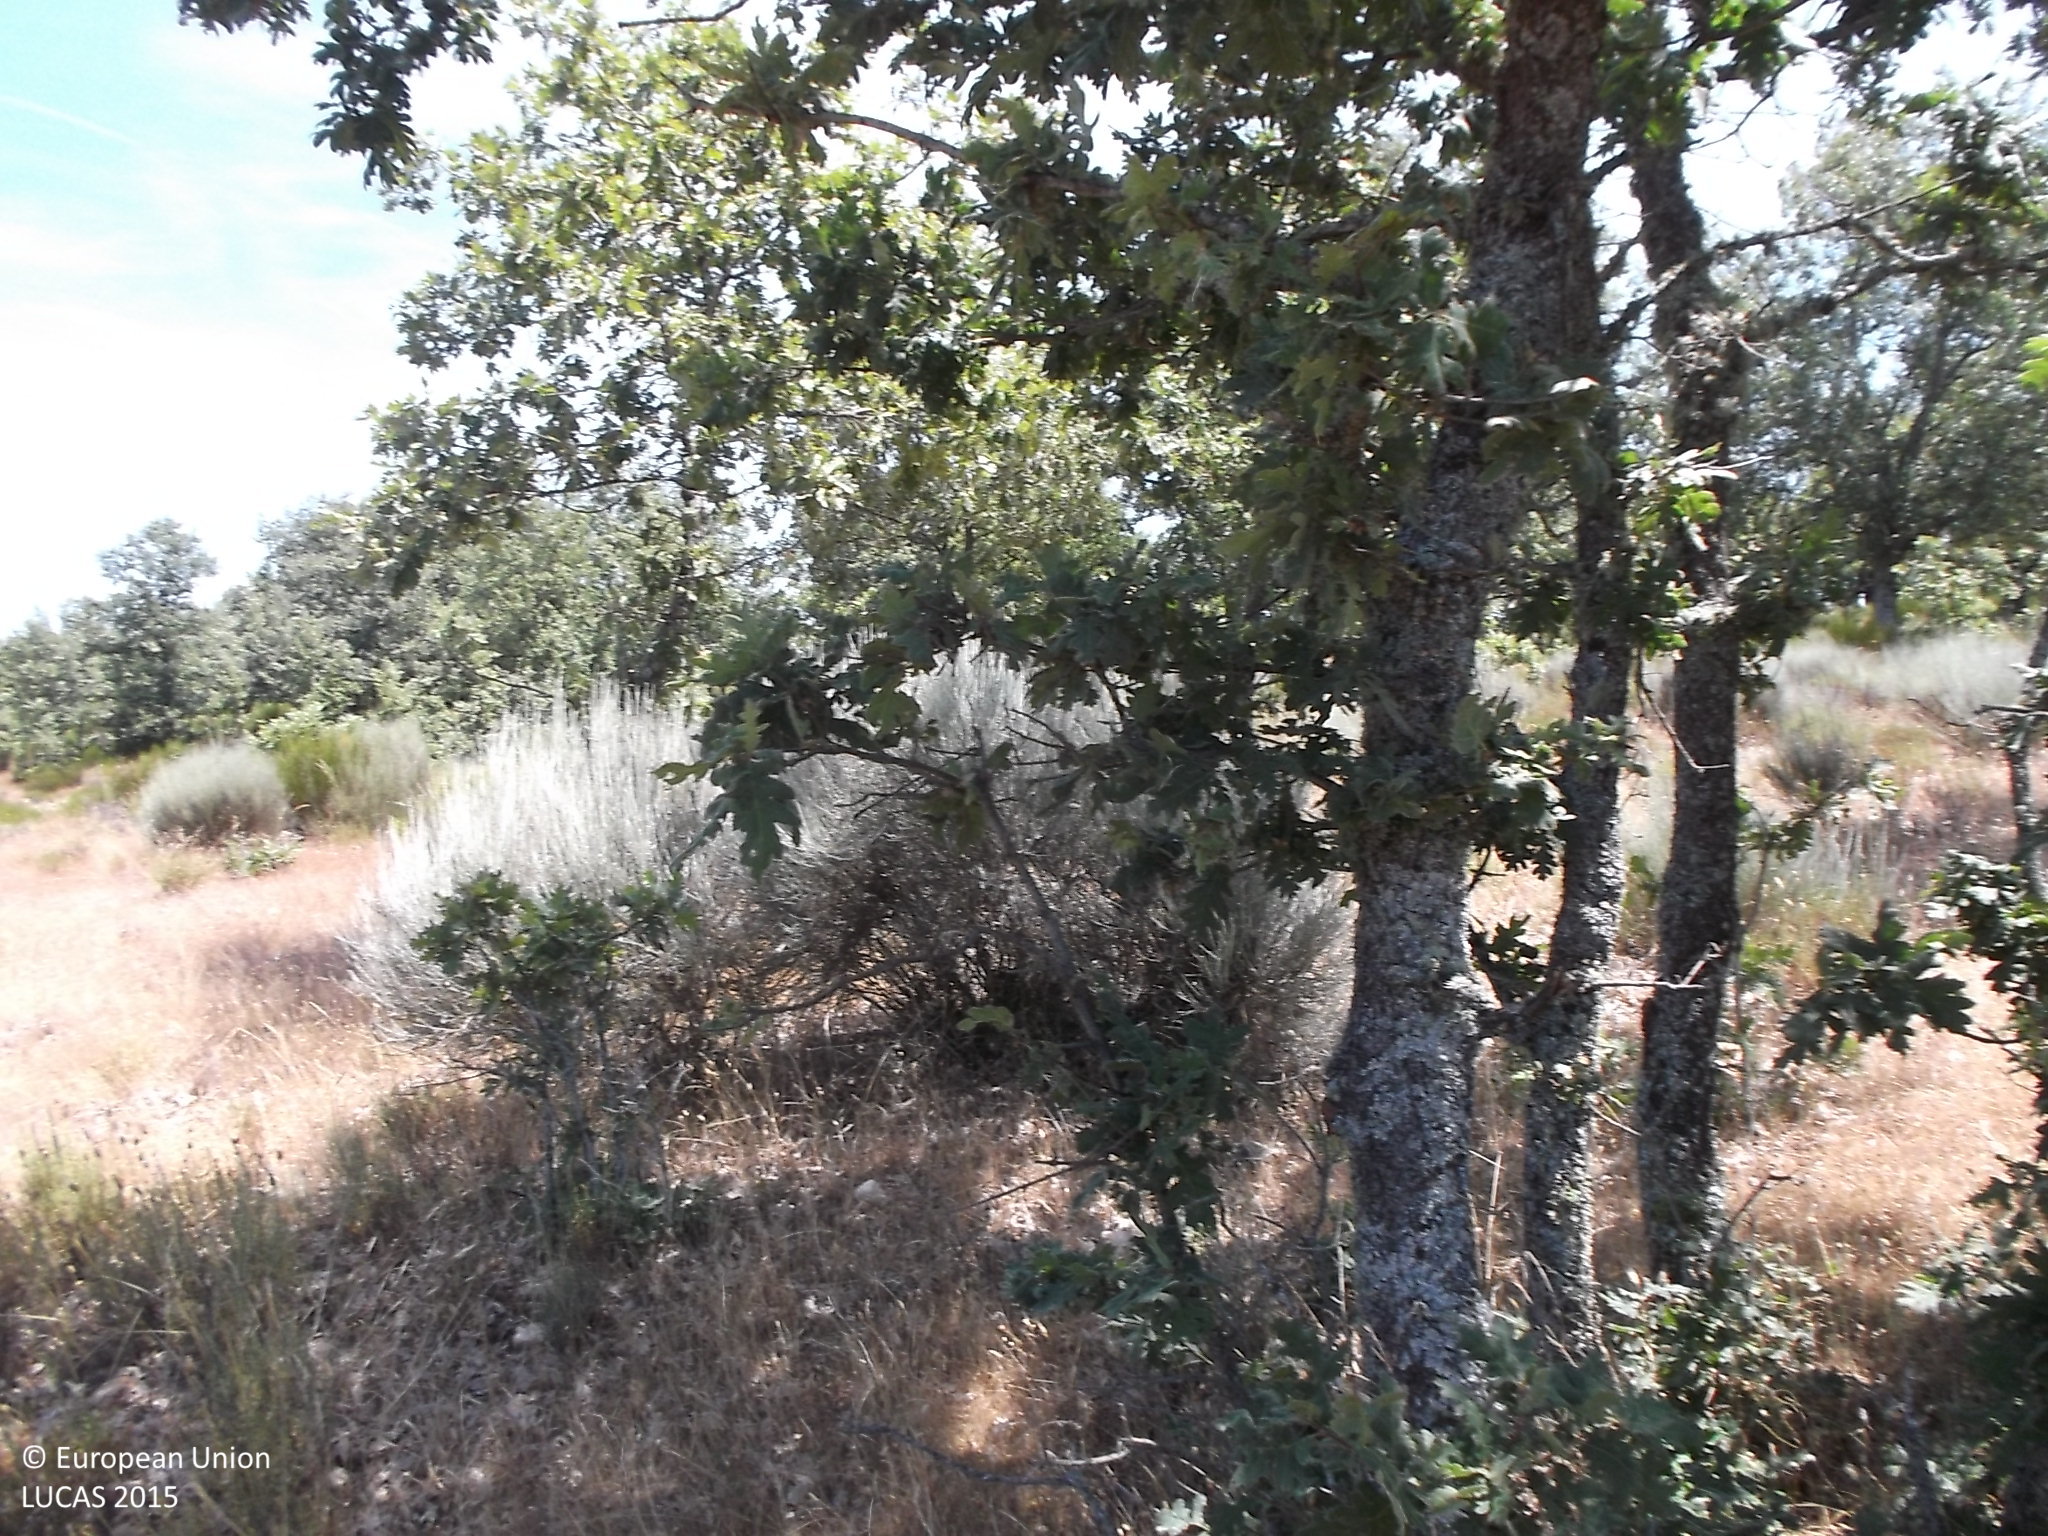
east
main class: Woodland
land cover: Broadleaved woodland
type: broadleaved evergreen forest
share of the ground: 25 - 50 %
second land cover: Shrubland without tree cover
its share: 25 - 50 %
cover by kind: broadleaved forest trees 40 %, shrubs 30 %, herbaceous plants 30 %
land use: Forestry
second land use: Agriculture (excluding fallow land and kitchen gardens)
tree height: < 5 m
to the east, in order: Broadleaved woodland; Shrubland without tree cover; Fences; Shrubland with sparse tree cover; Shrubland without tree cover
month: July
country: ES
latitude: 41.2418
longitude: -6.4570
